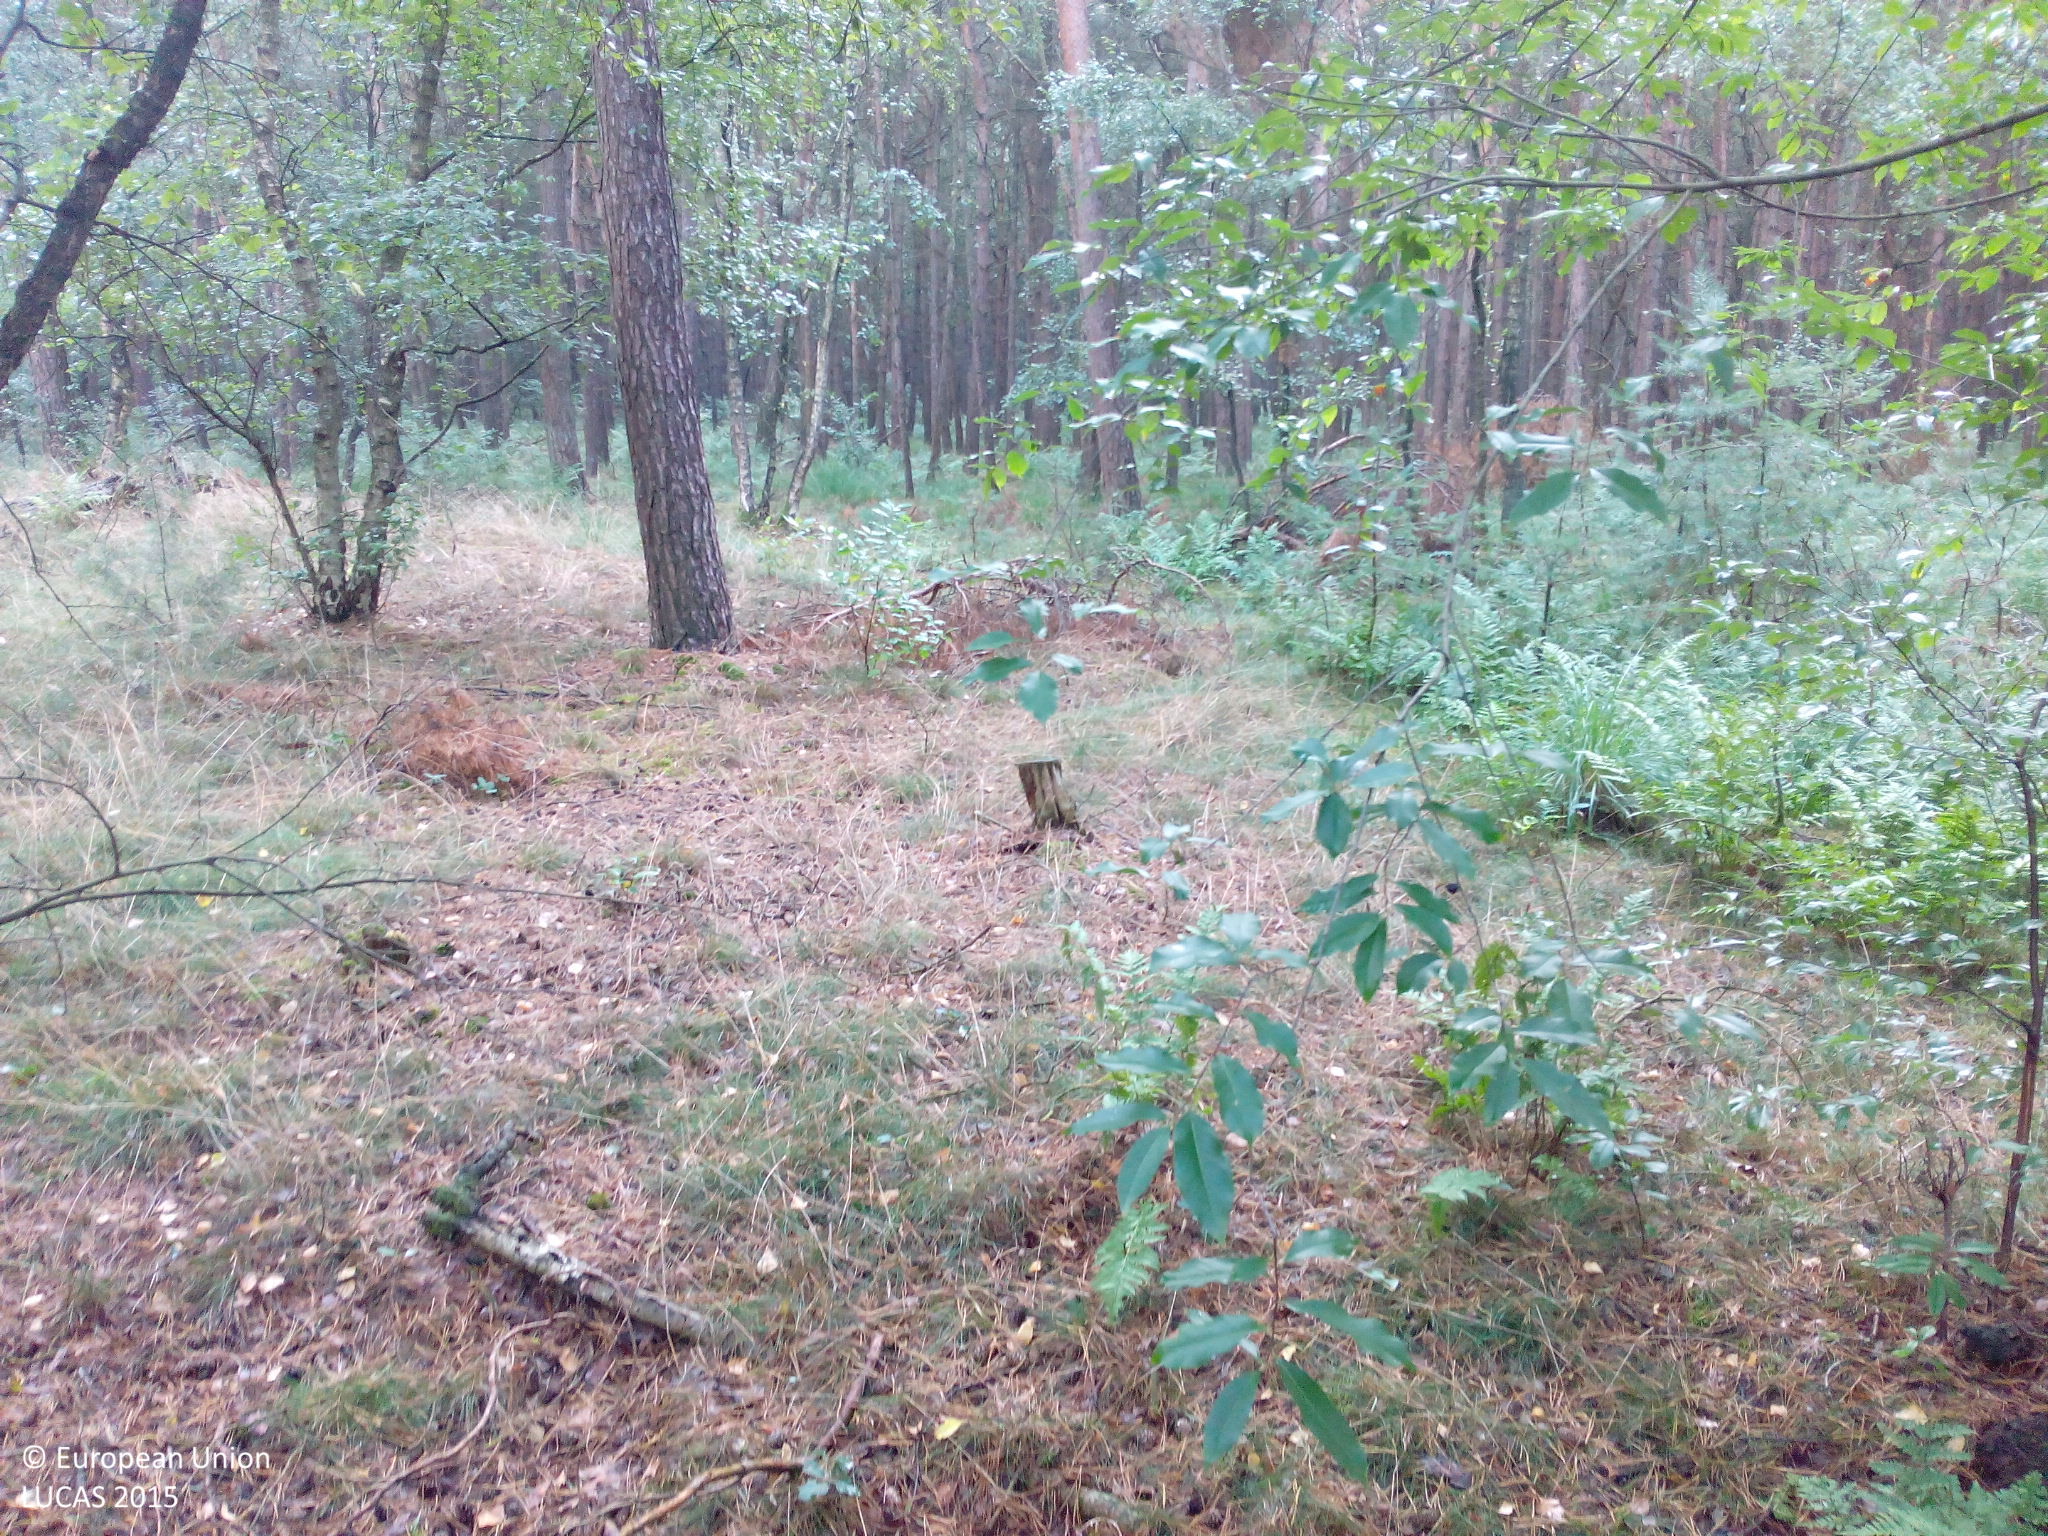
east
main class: Woodland
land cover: Pine dominated mixed woodland
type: hemiboreal forest and nemoral coniferous forest and mixed broadleaved-coniferous forest
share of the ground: > 75 %
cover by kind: coniferous forest trees 65 %, broadleaved forest trees 35 %
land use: Forestry
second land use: Amenities, museums, leisure
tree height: > 5 m
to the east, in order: Pine dominated mixed woodland; Pine dominated coniferous woodland; Spruce dominated coniferous woodland; Broadleaved woodland; Tracks; Spruce dominated coniferous woodland; Tracks; Other coniferous woodland
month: August
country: NL
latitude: 51.5545
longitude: 5.5127
